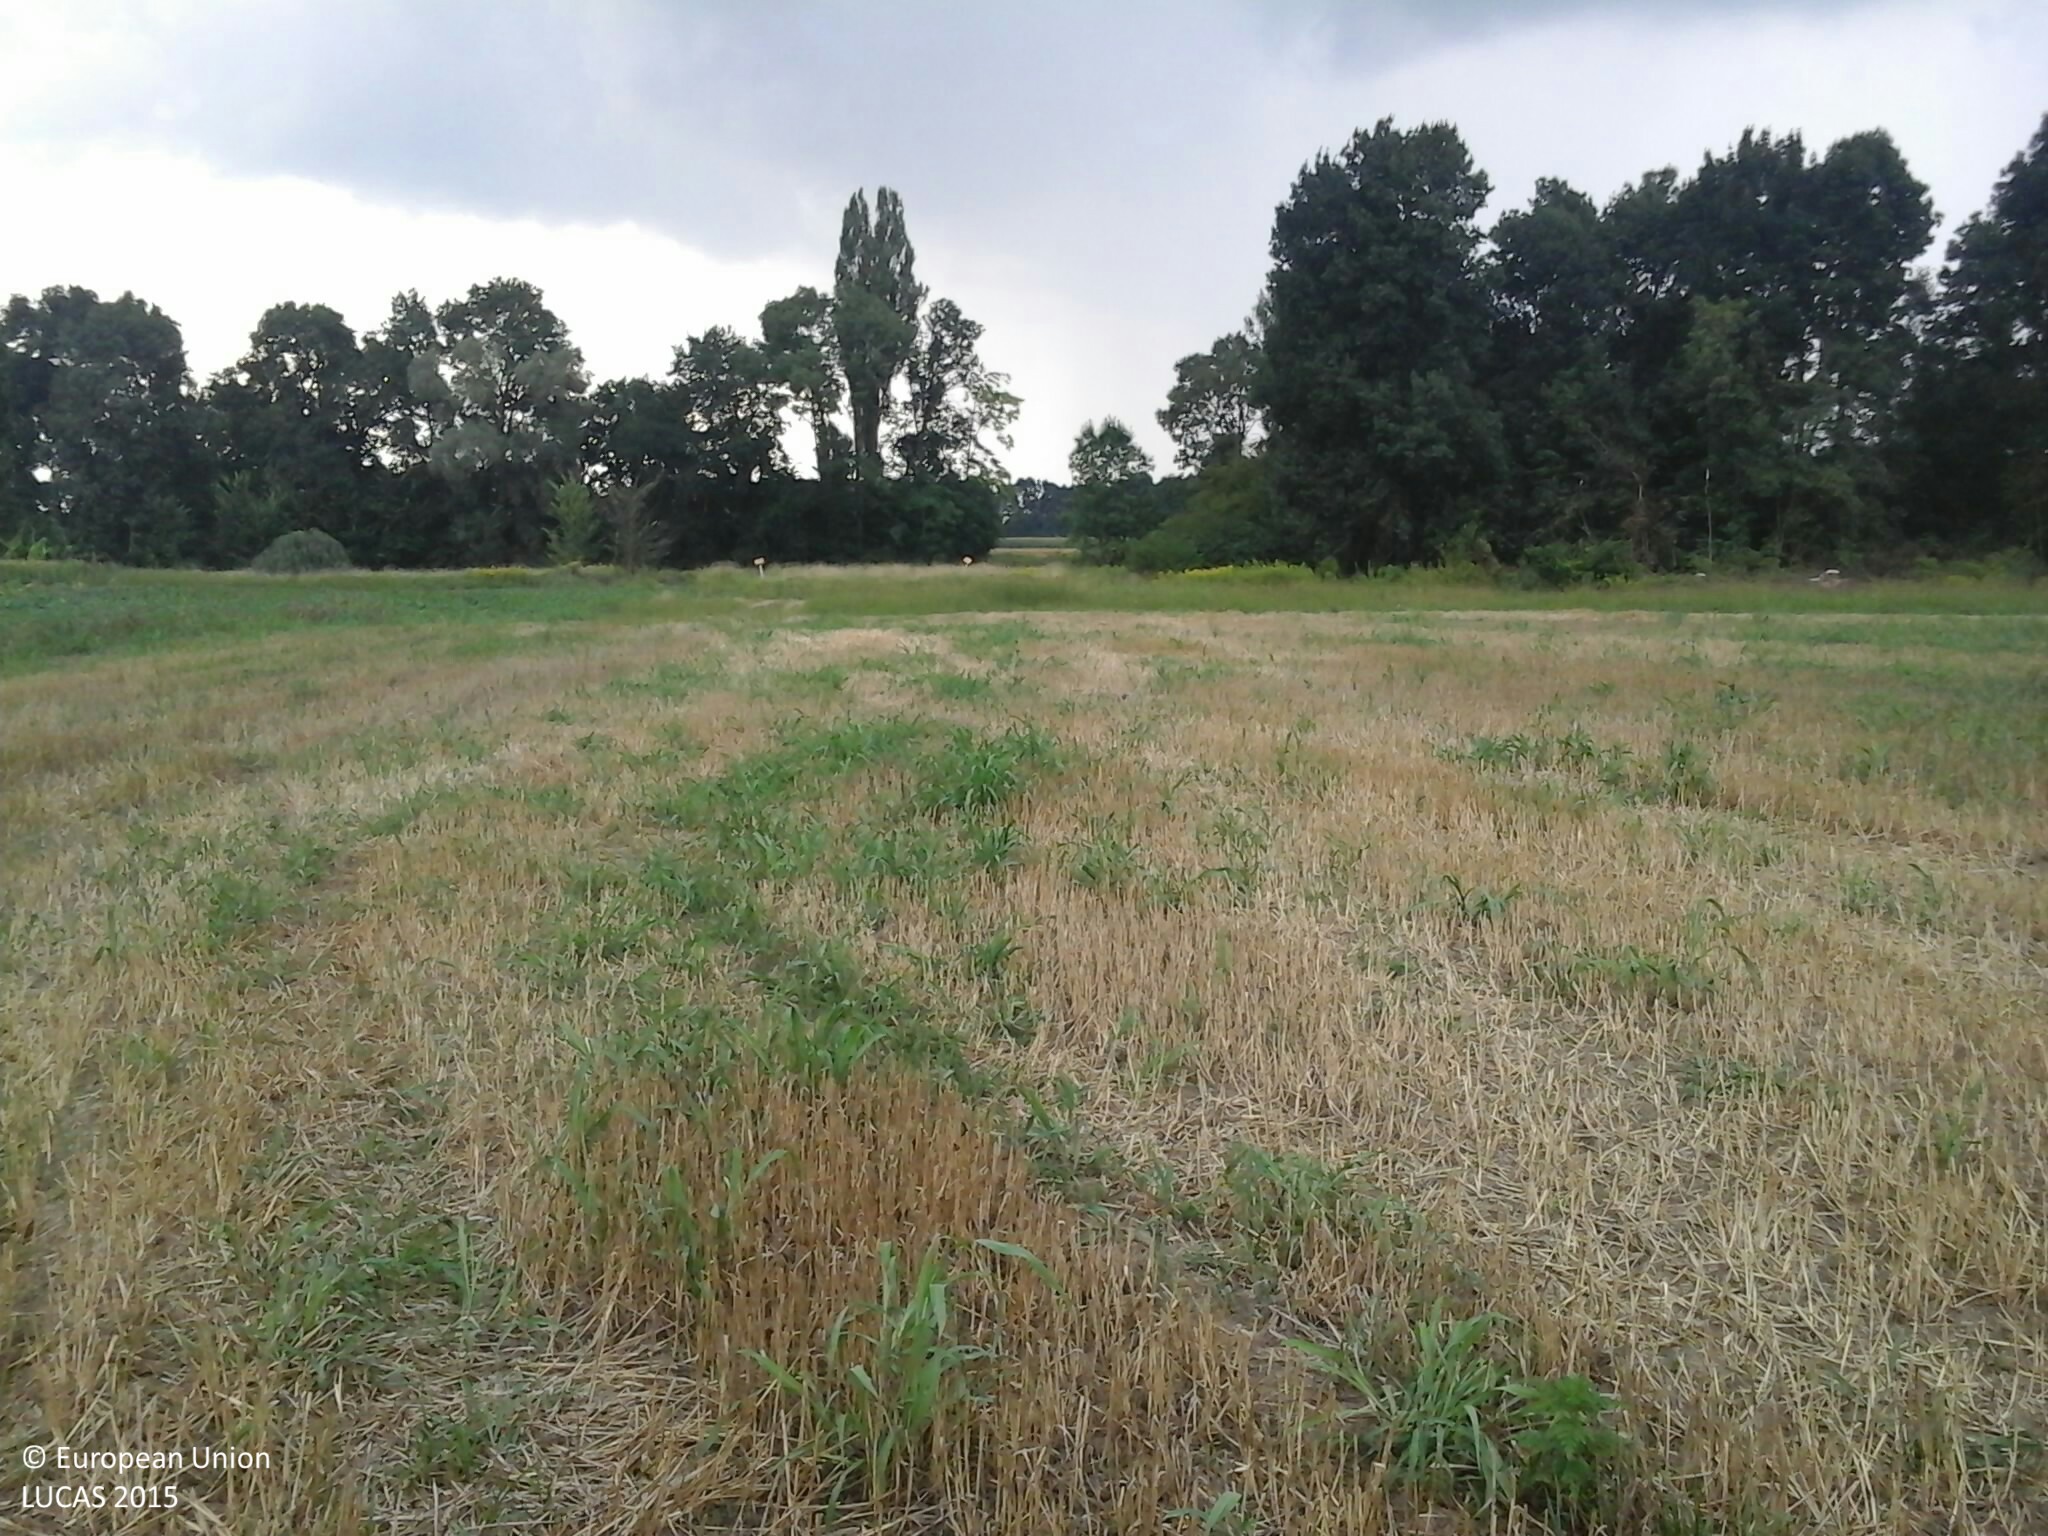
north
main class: Cropland
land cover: Common wheat
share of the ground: 25 - 50 %
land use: Agriculture (excluding fallow land and kitchen gardens)
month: August
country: HU
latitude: 45.8064
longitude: 18.1250
